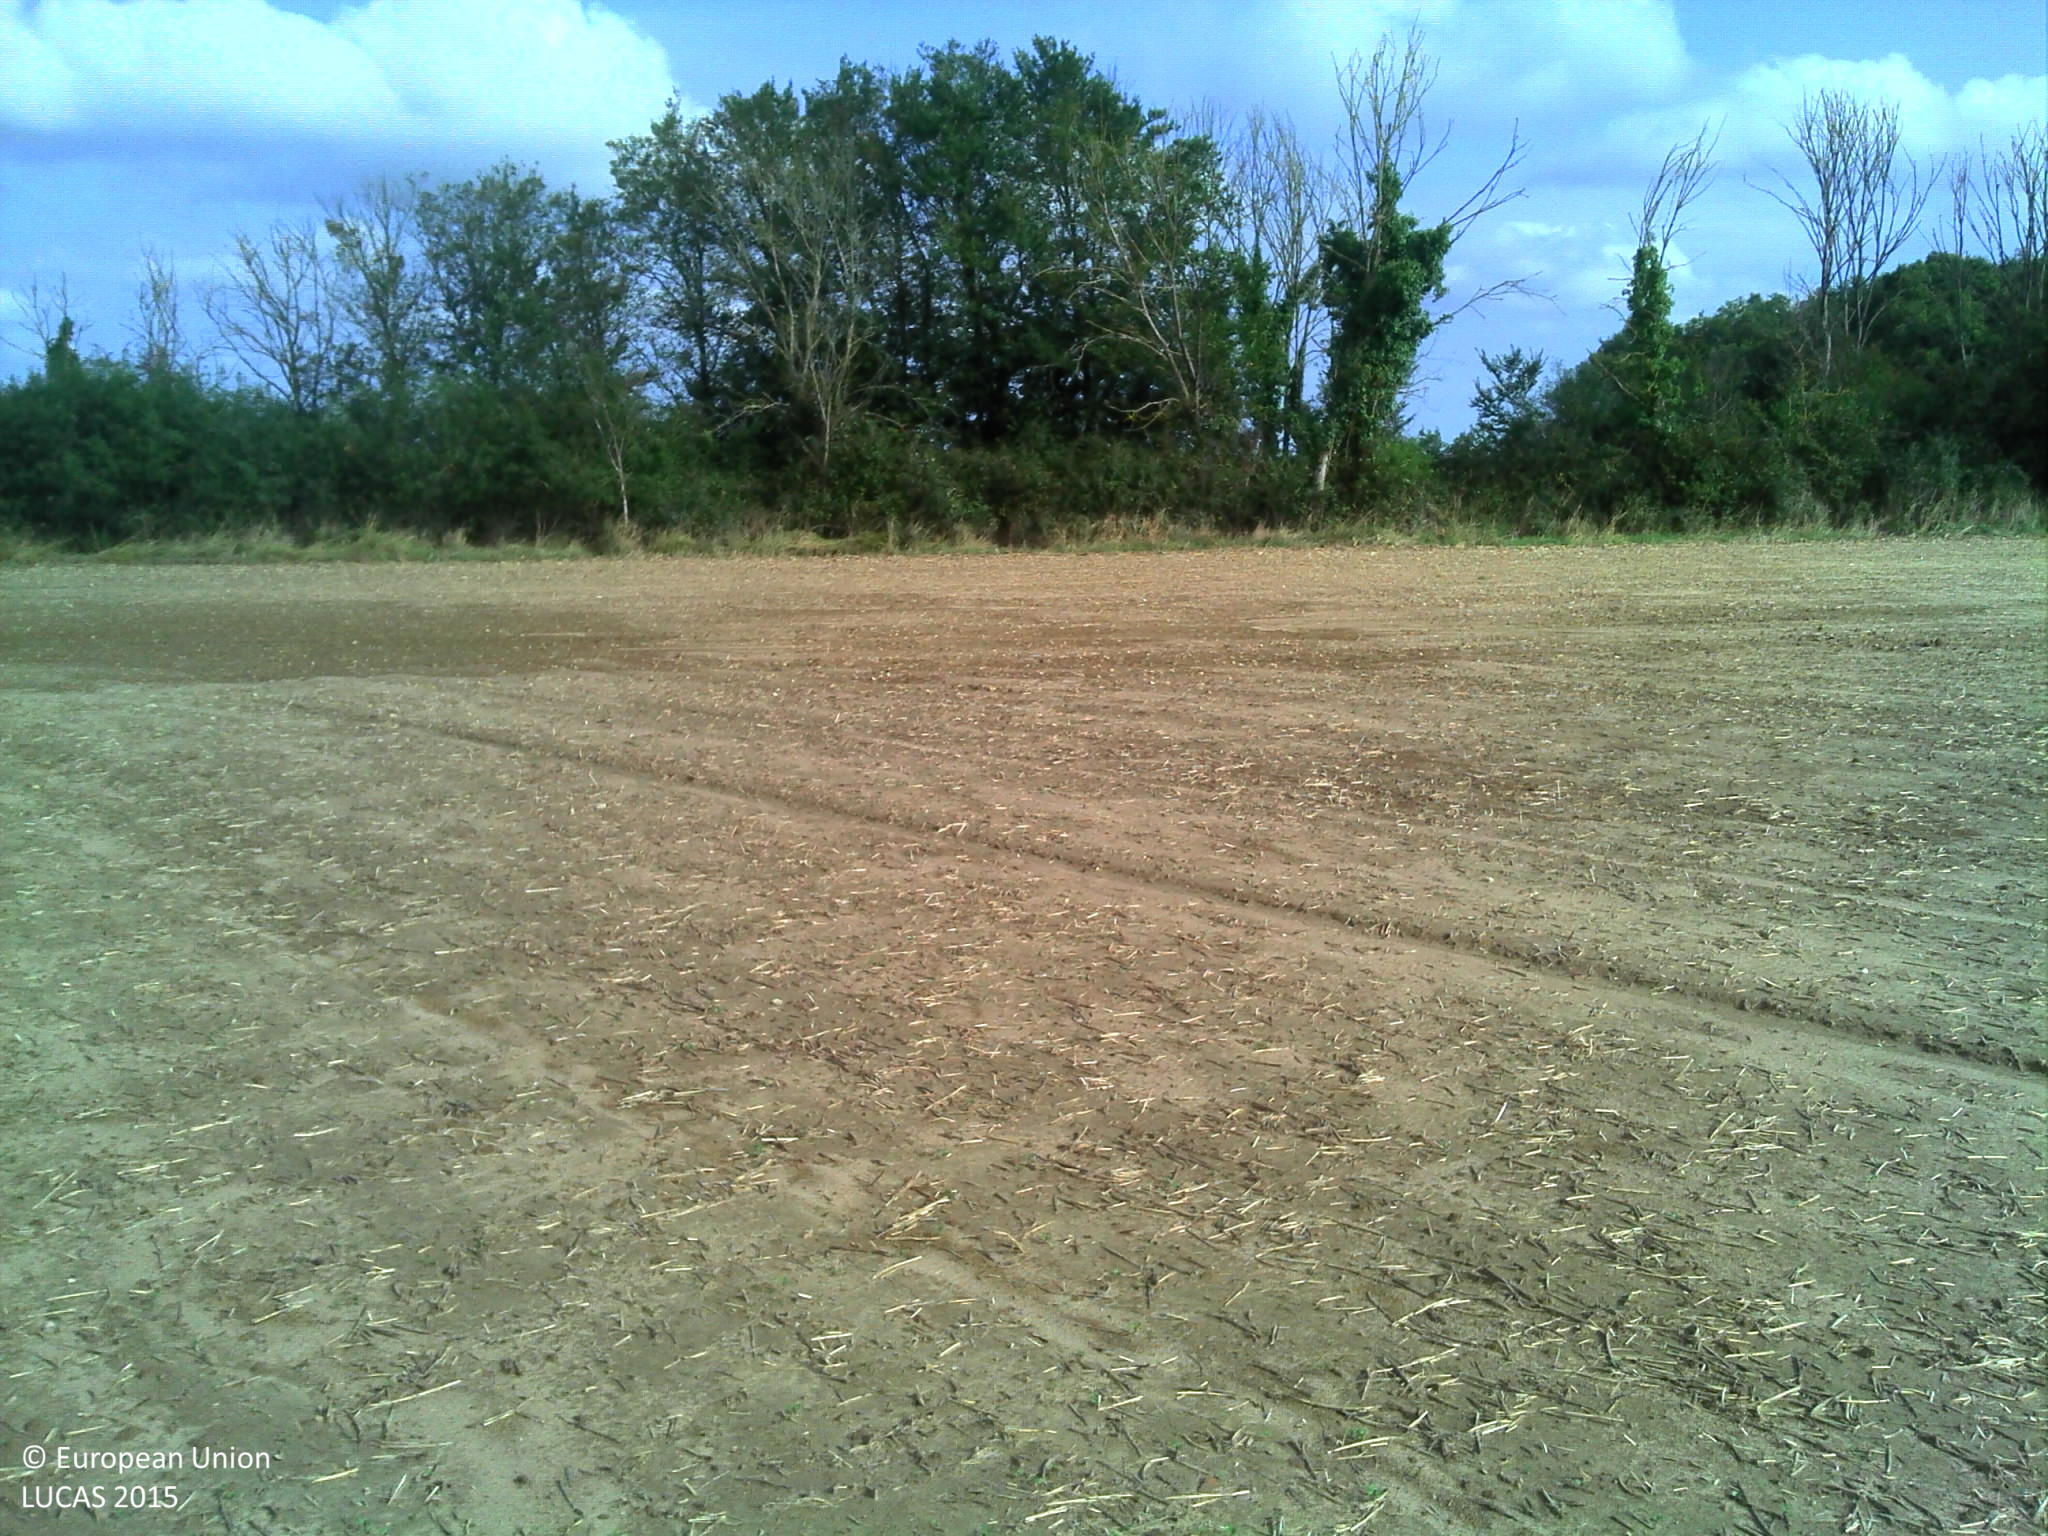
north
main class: Cropland
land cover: Other fibre and oleaginous crops
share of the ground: < 10 %
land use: Agriculture (excluding fallow land and kitchen gardens)
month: September
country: FR
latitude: 46.9129
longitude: 1.4403
